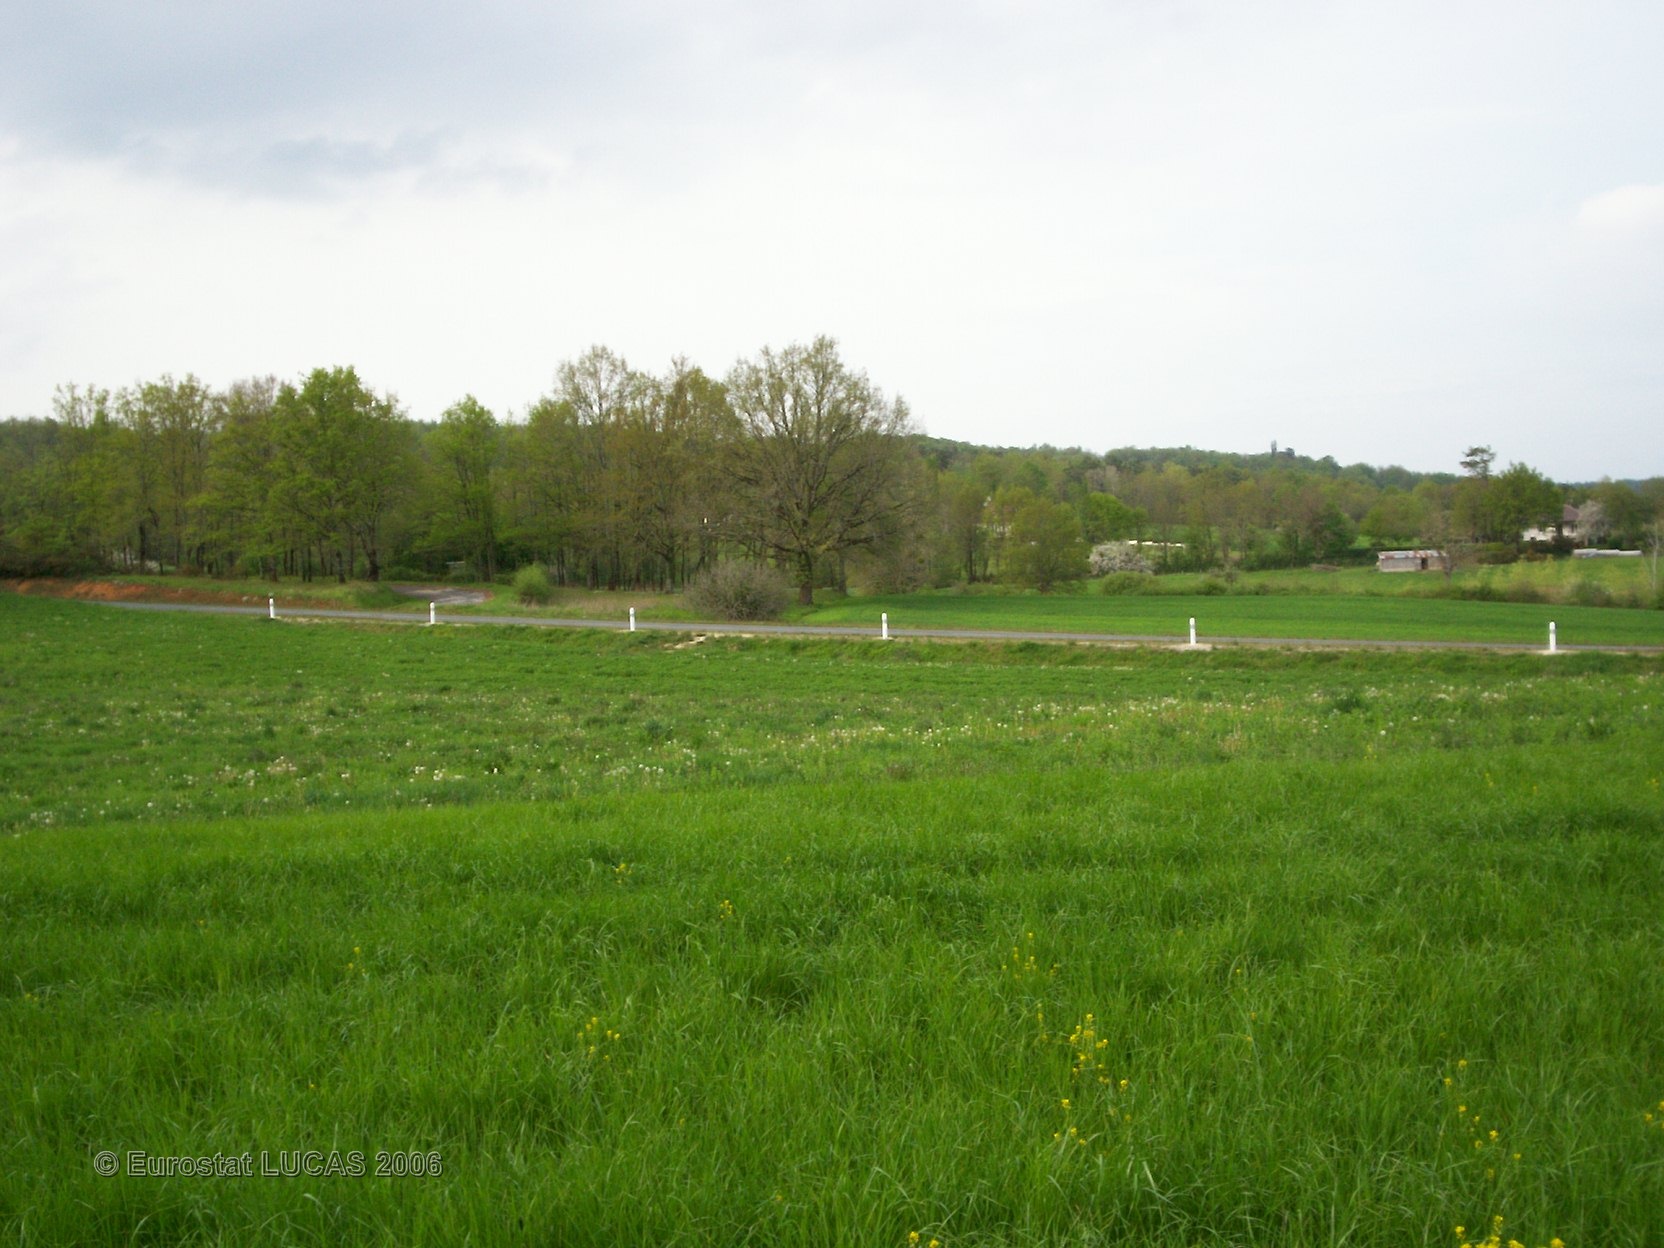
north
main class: Grassland
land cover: Grassland without tree/shrub cover
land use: Agriculture (excluding fallow land and kitchen gardens)
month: April
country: FR
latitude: 45.4953
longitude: 0.7369
